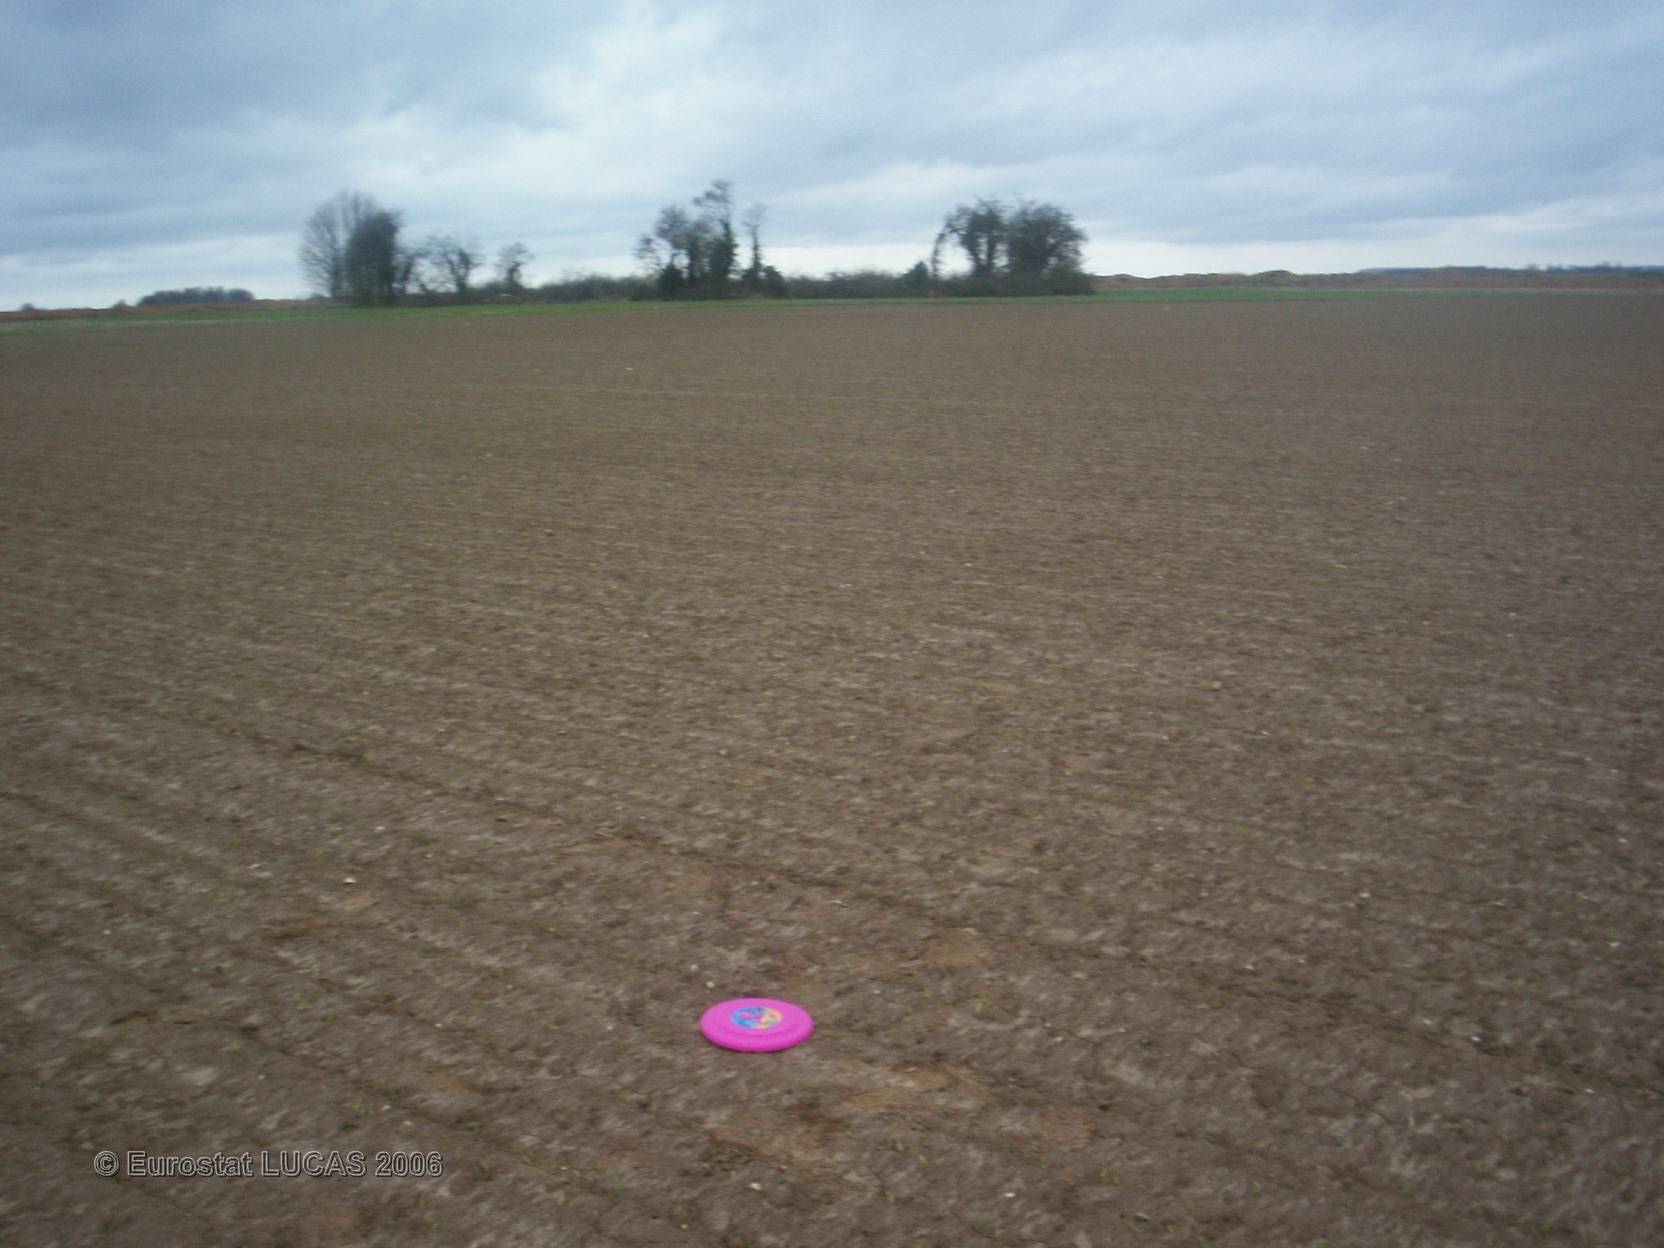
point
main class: Cropland
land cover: Maize
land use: Agriculture (excluding fallow land and kitchen gardens)
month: April
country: FR
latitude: 49.9680
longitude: 2.6971
